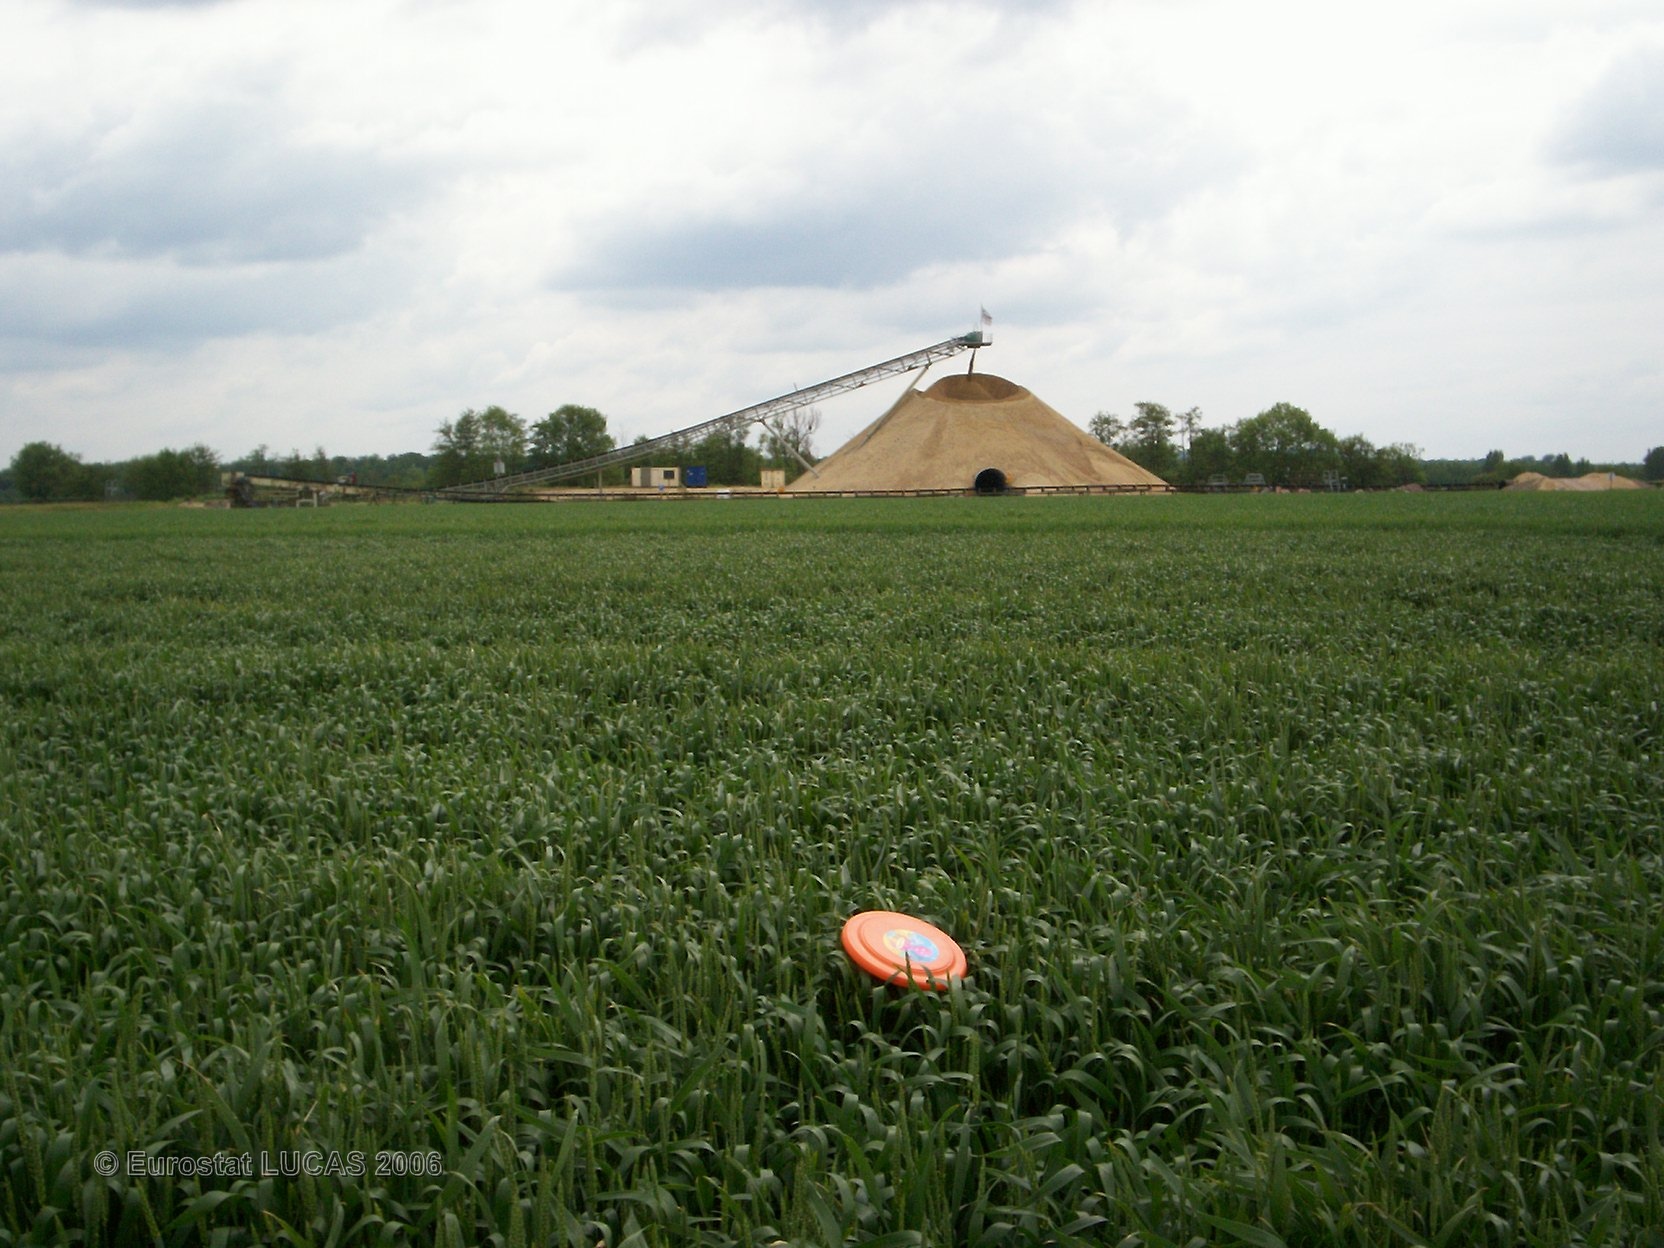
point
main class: Cropland
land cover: Common wheat
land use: Agriculture (excluding fallow land and kitchen gardens)
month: June
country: FR
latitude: 49.3385
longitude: 2.7365
